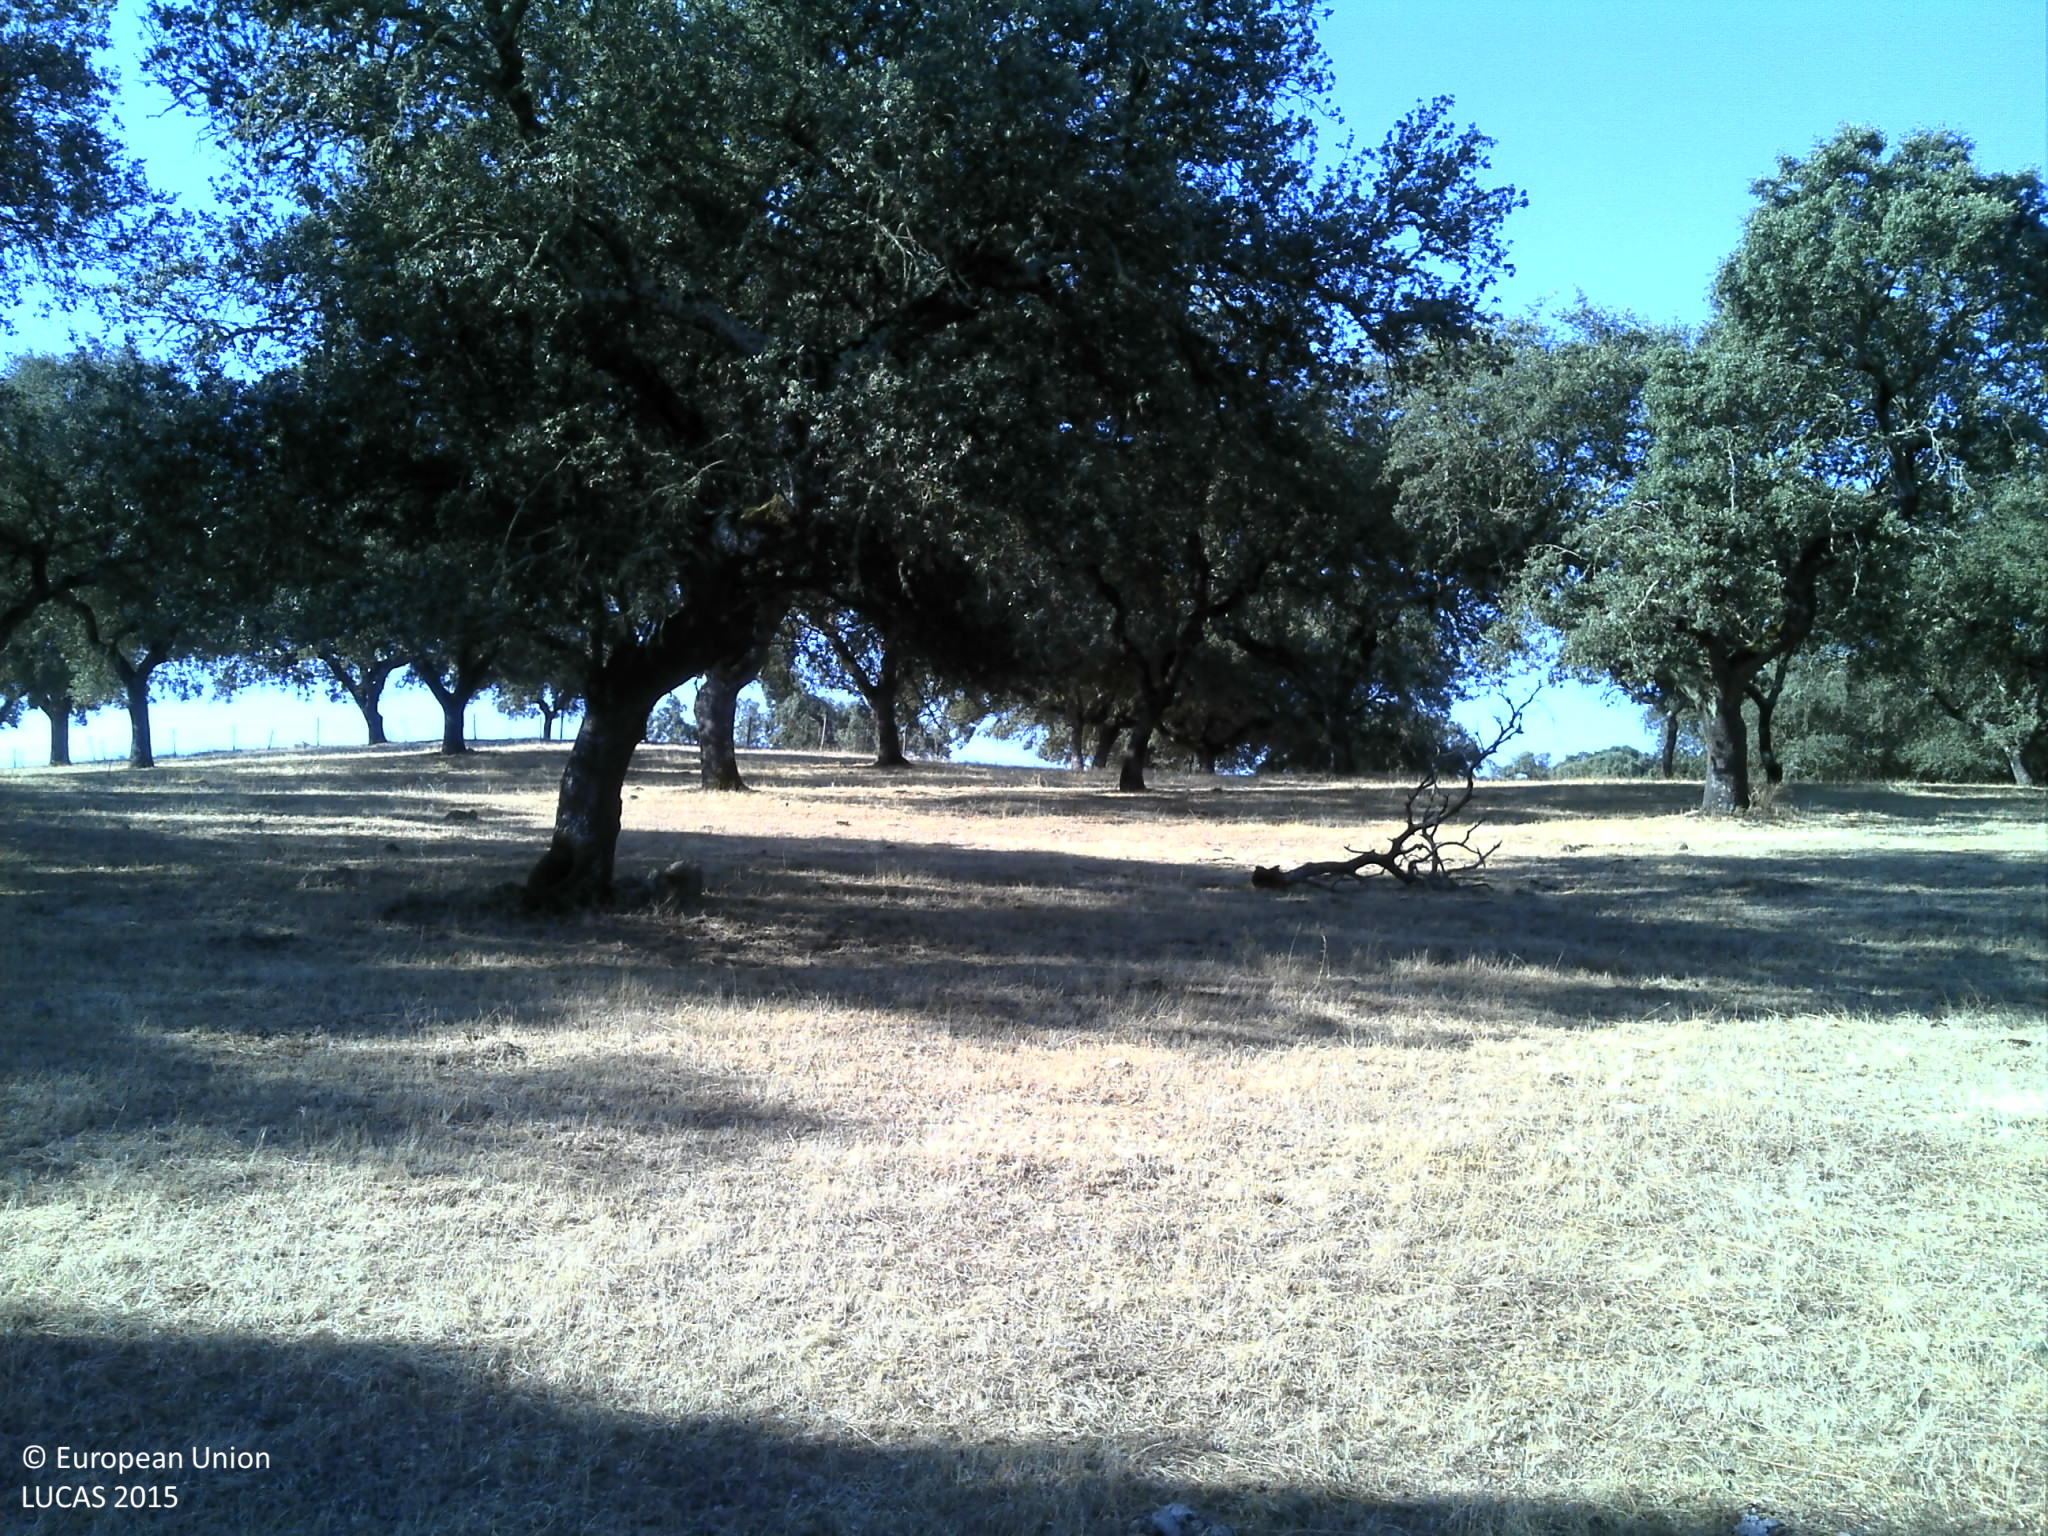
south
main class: Woodland
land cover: Broadleaved woodland
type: broadleaved evergreen forest
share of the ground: 25 - 50 %
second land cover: Grassland without tree/shrub cover
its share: 25 - 50 %
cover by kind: unconsolidated bare surface 50 %, broadleaved forest trees 25 %, herbaceous plants 25 %
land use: Forestry
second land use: Agriculture (excluding fallow land and kitchen gardens)
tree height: > 5 m
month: July
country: PT
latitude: 39.0316
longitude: -7.3984
